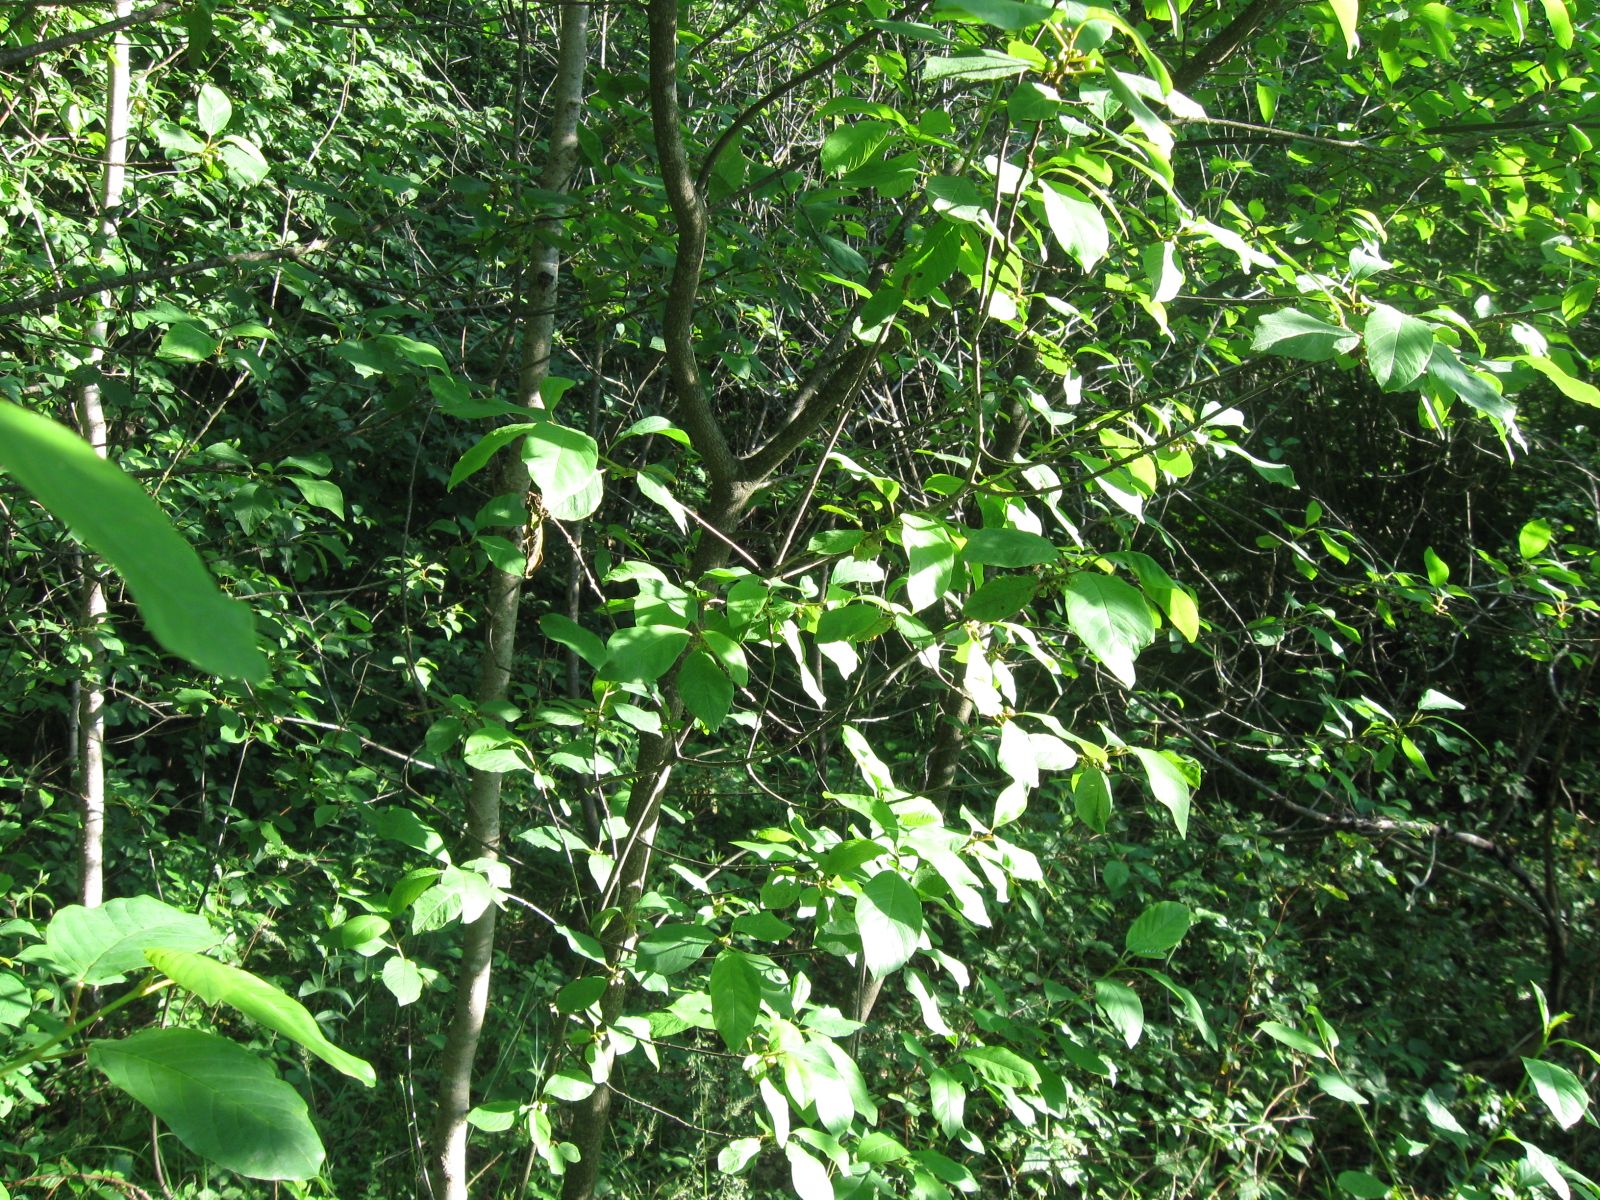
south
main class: Woodland
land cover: Broadleaved woodland
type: non-riverine alder, birch or aspen forest
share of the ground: > 75 %
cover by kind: broadleaved forest trees 95 %, herbaceous plants 5 %
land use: Forestry
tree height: > 5 m
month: June
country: LT
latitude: 54.1624
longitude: 24.7040
